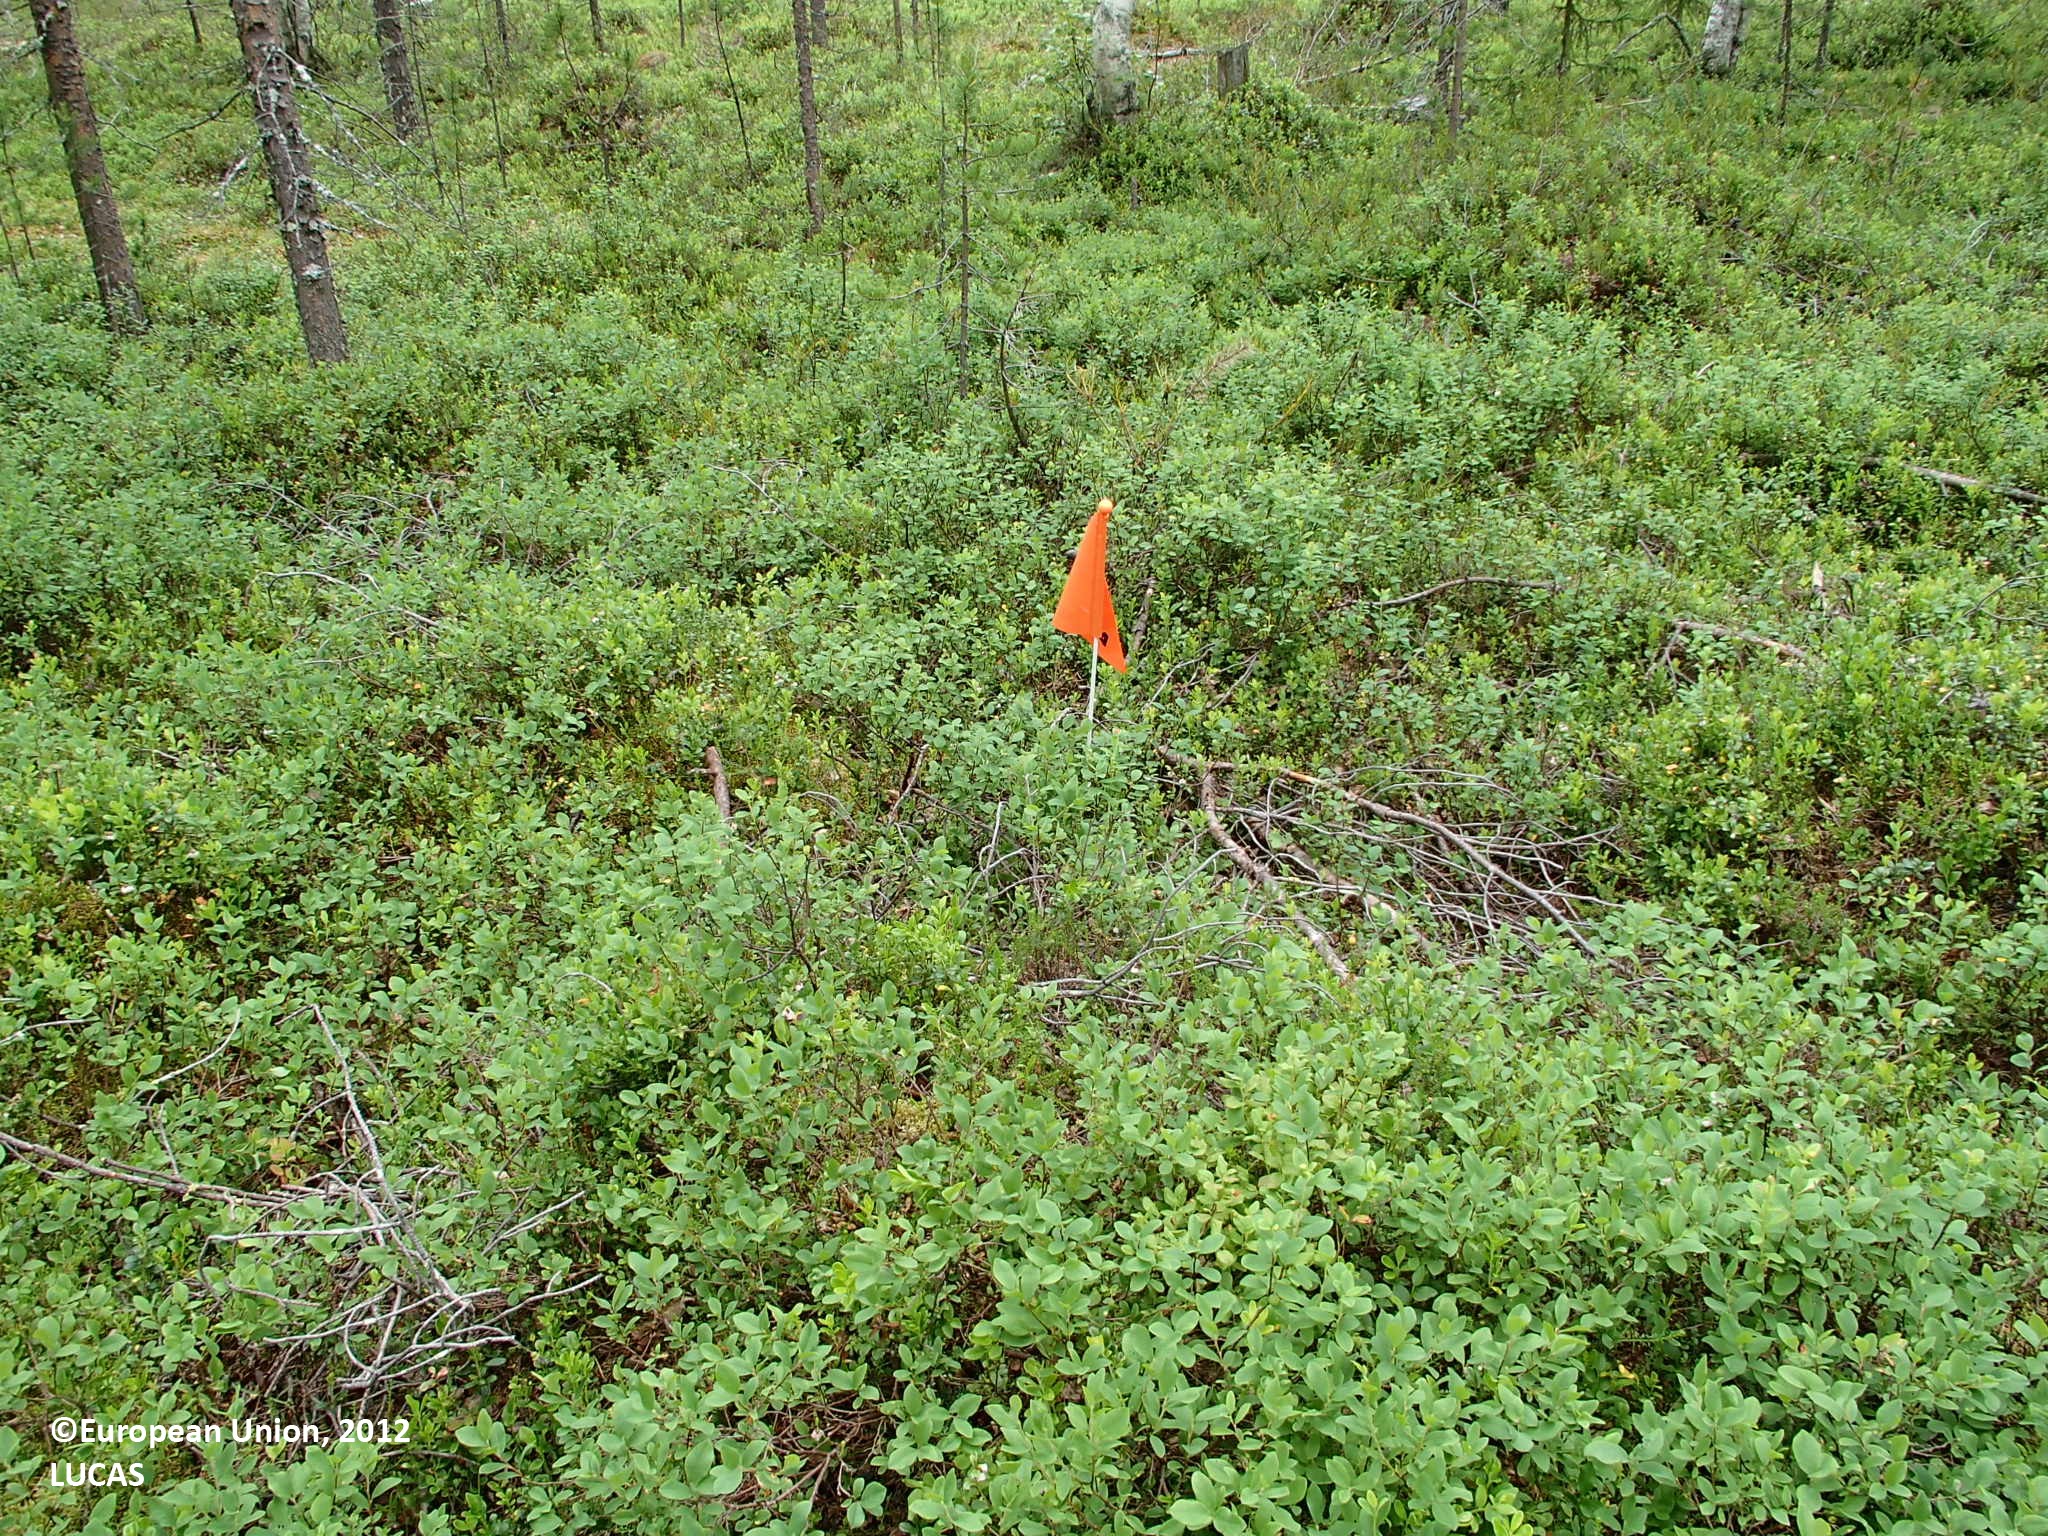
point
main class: Woodland
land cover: Other mixed woodland
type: boreal forest
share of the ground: 50 - 75 %
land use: Forestry
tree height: > 5 m
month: July
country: FI
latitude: 67.2209
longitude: 25.7271
